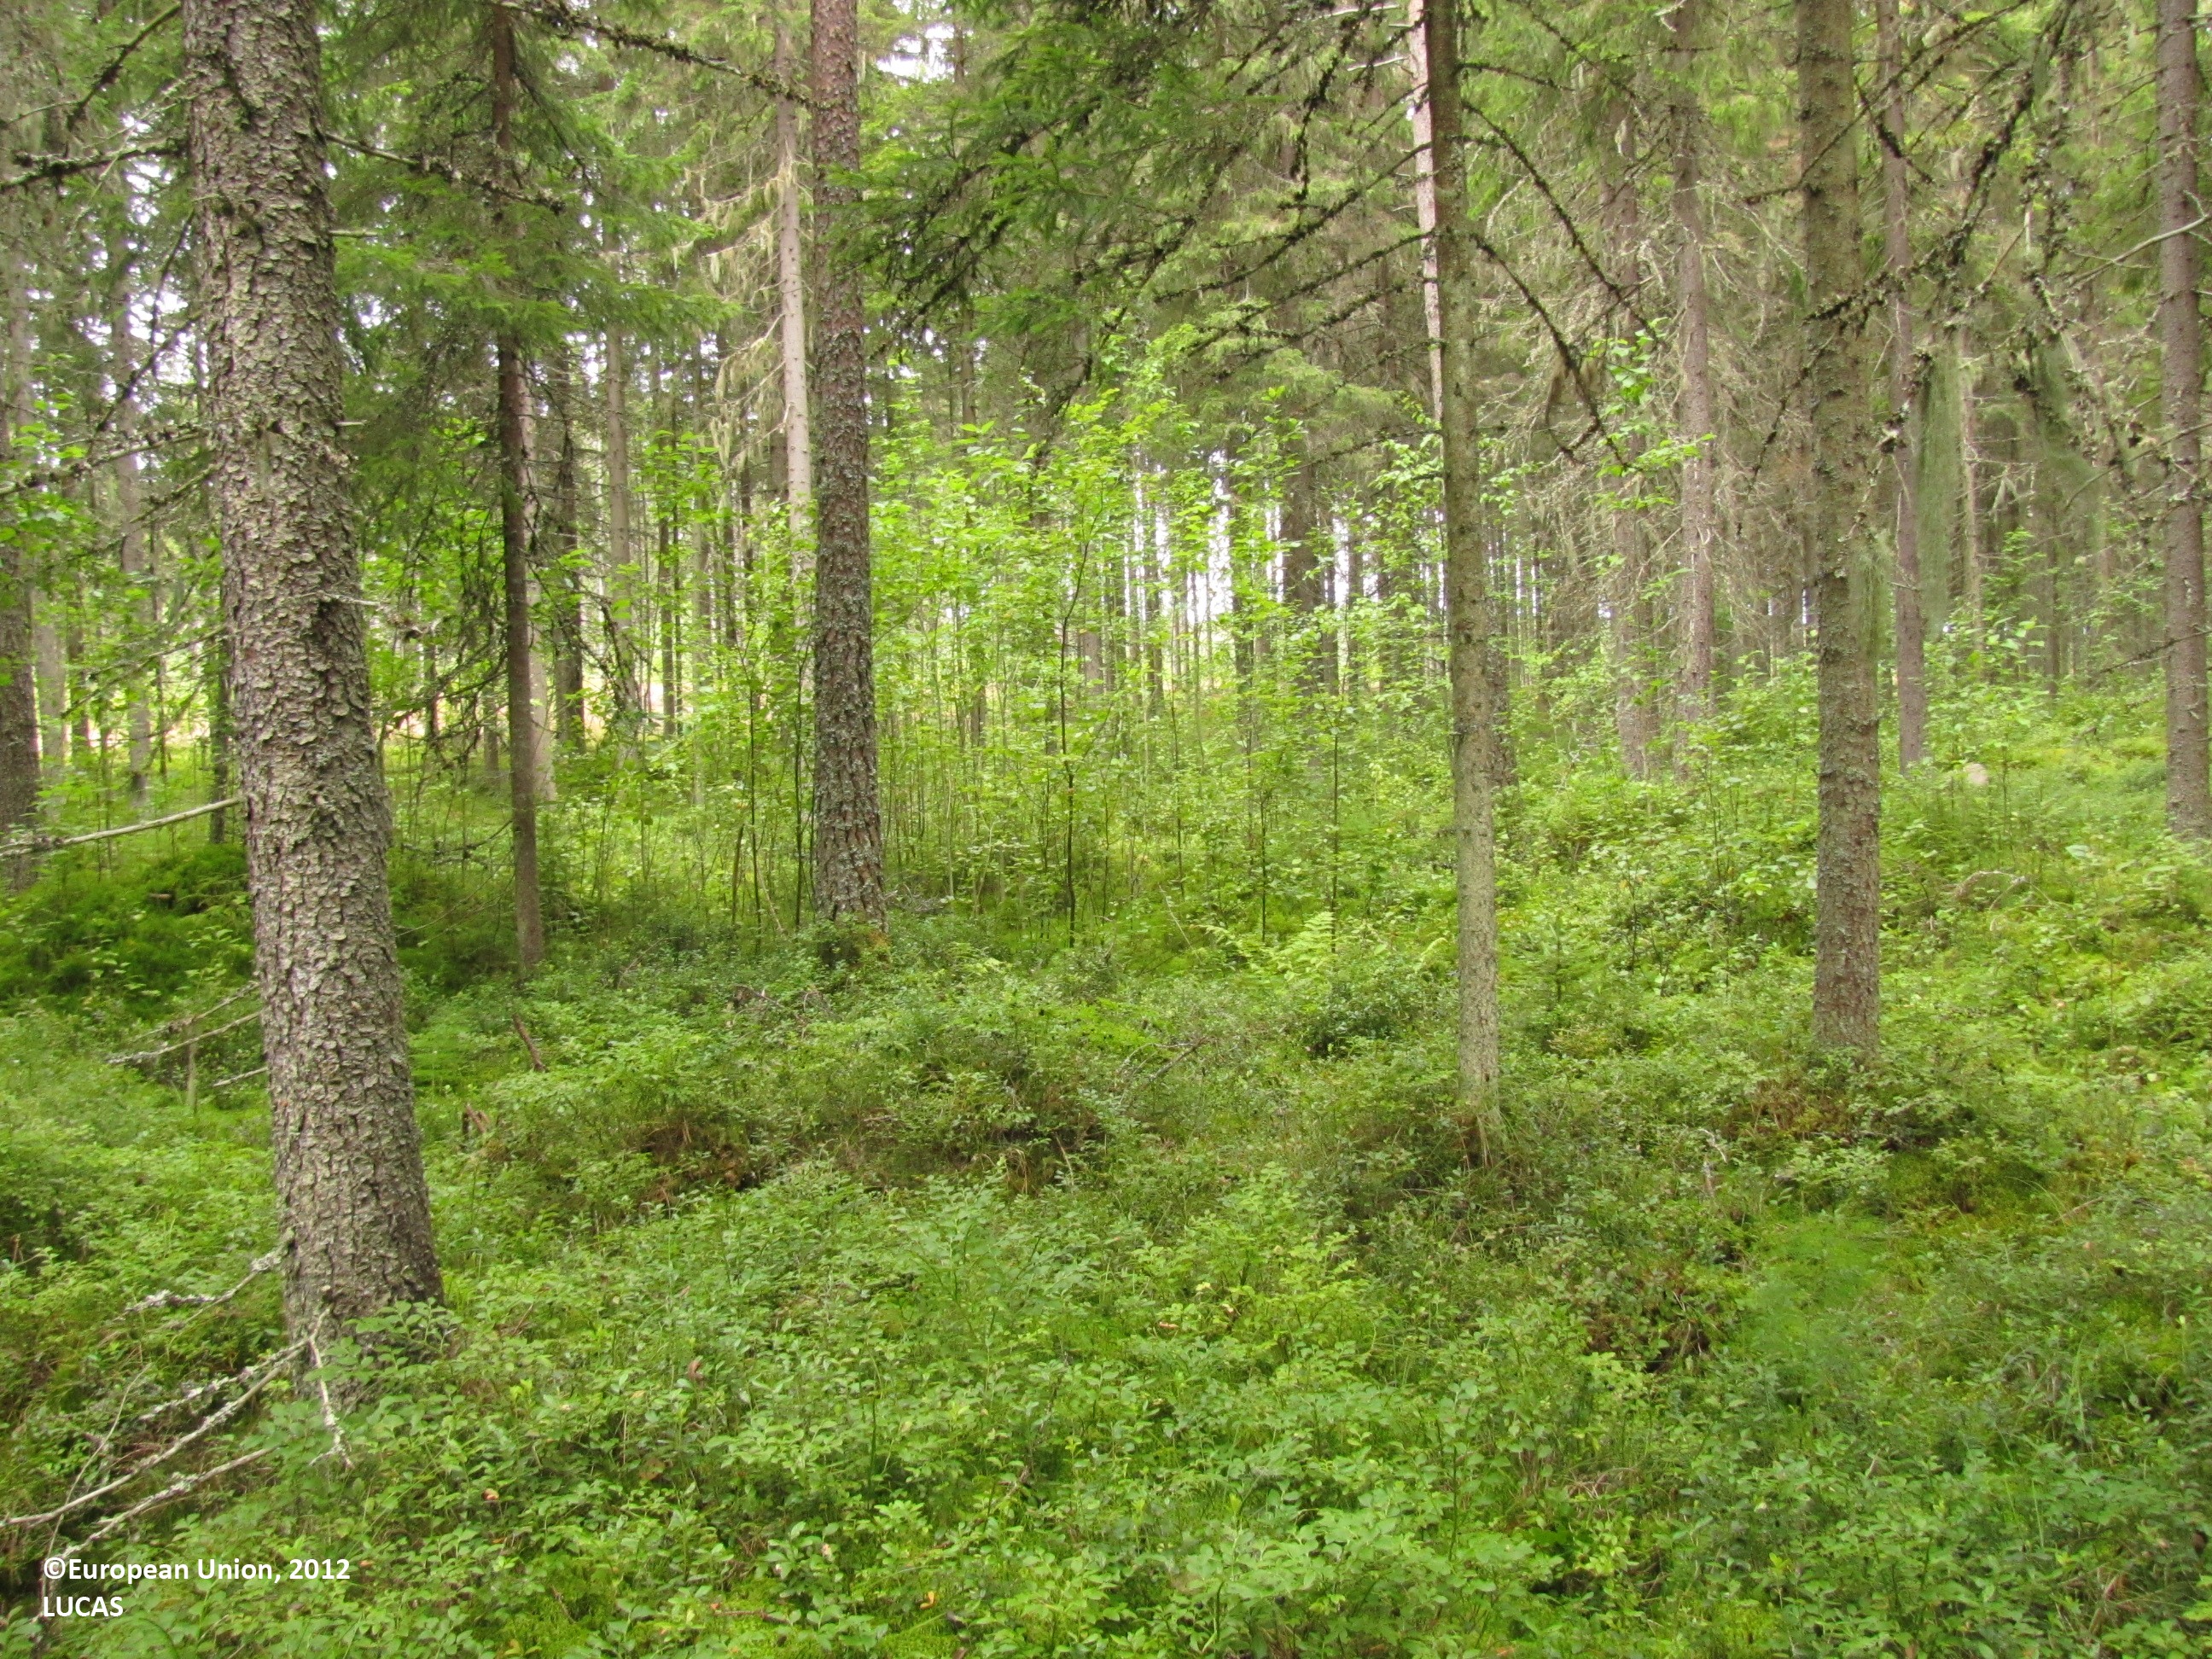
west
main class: Woodland
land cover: Spruce dominated coniferous woodland
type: boreal forest
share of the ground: > 75 %
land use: Forestry
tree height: > 5 m
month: August
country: FI
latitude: 61.8361
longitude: 22.8862
